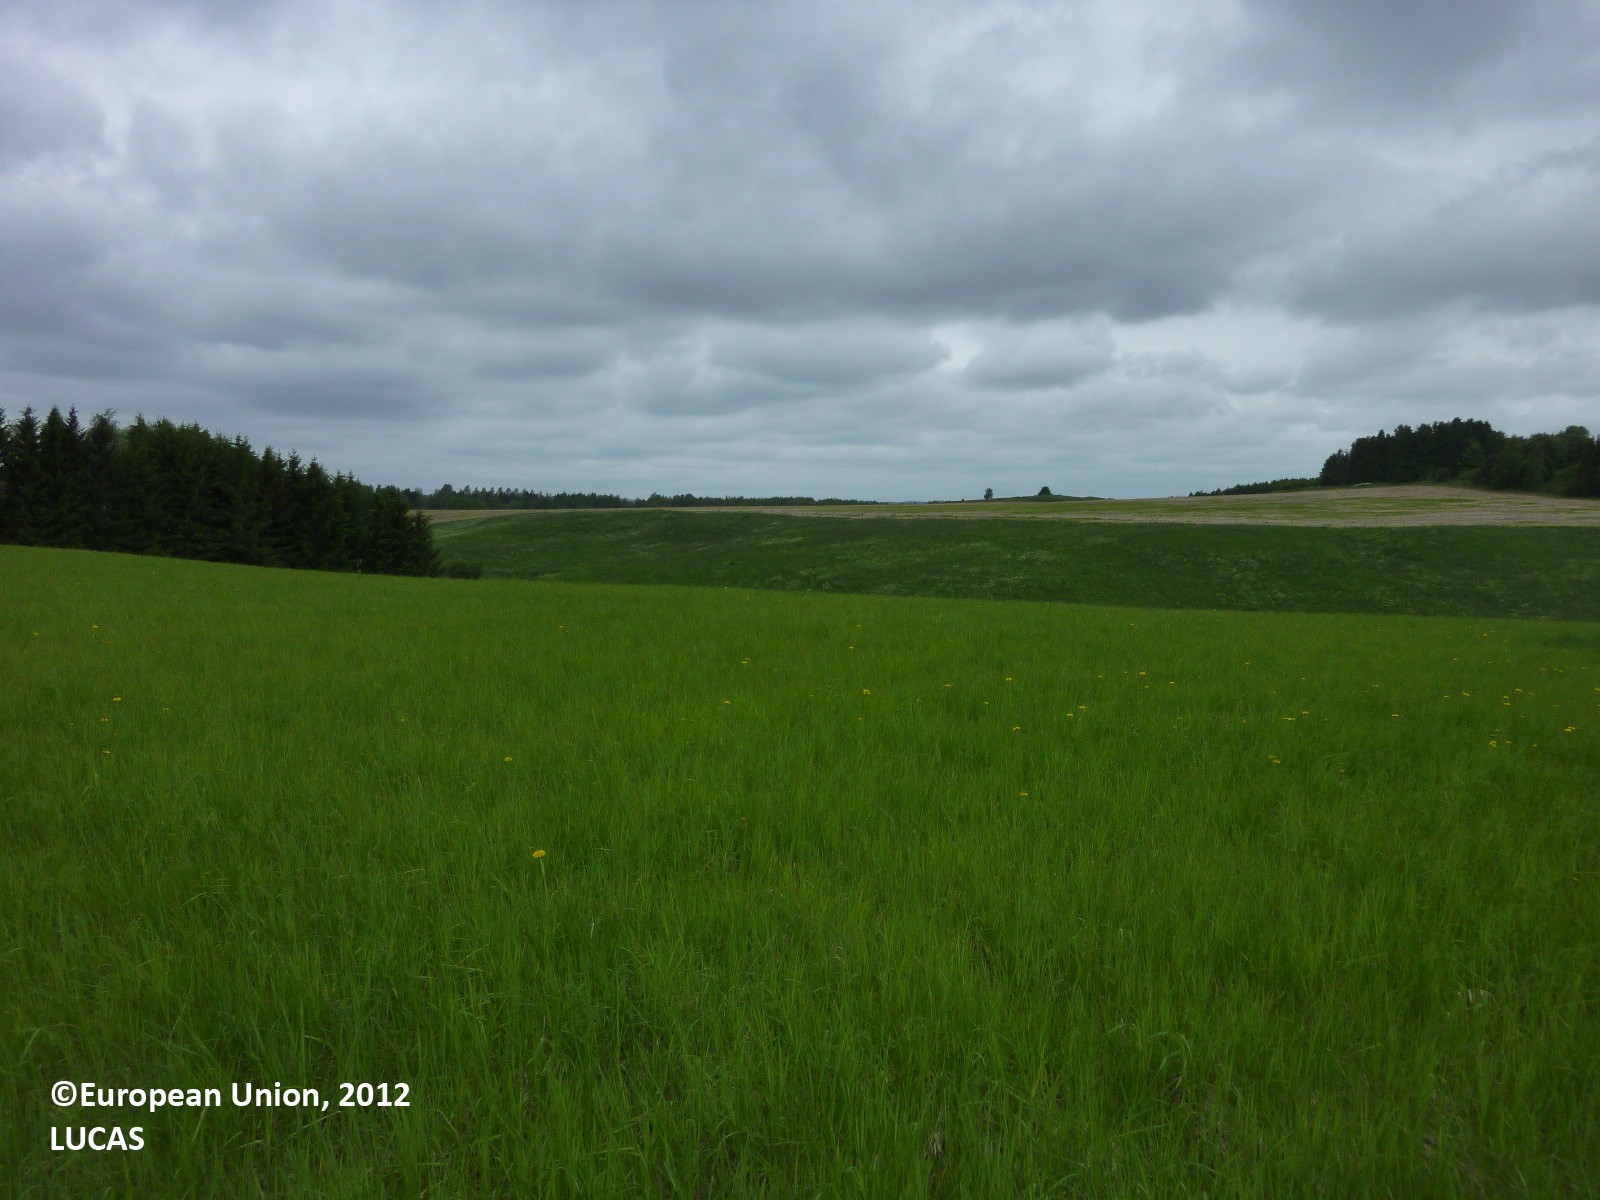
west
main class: Cropland
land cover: Temporary grasslands
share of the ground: > 75 %
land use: Agriculture (excluding fallow land and kitchen gardens)
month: June
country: FI
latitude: 60.4614
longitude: 22.7115
